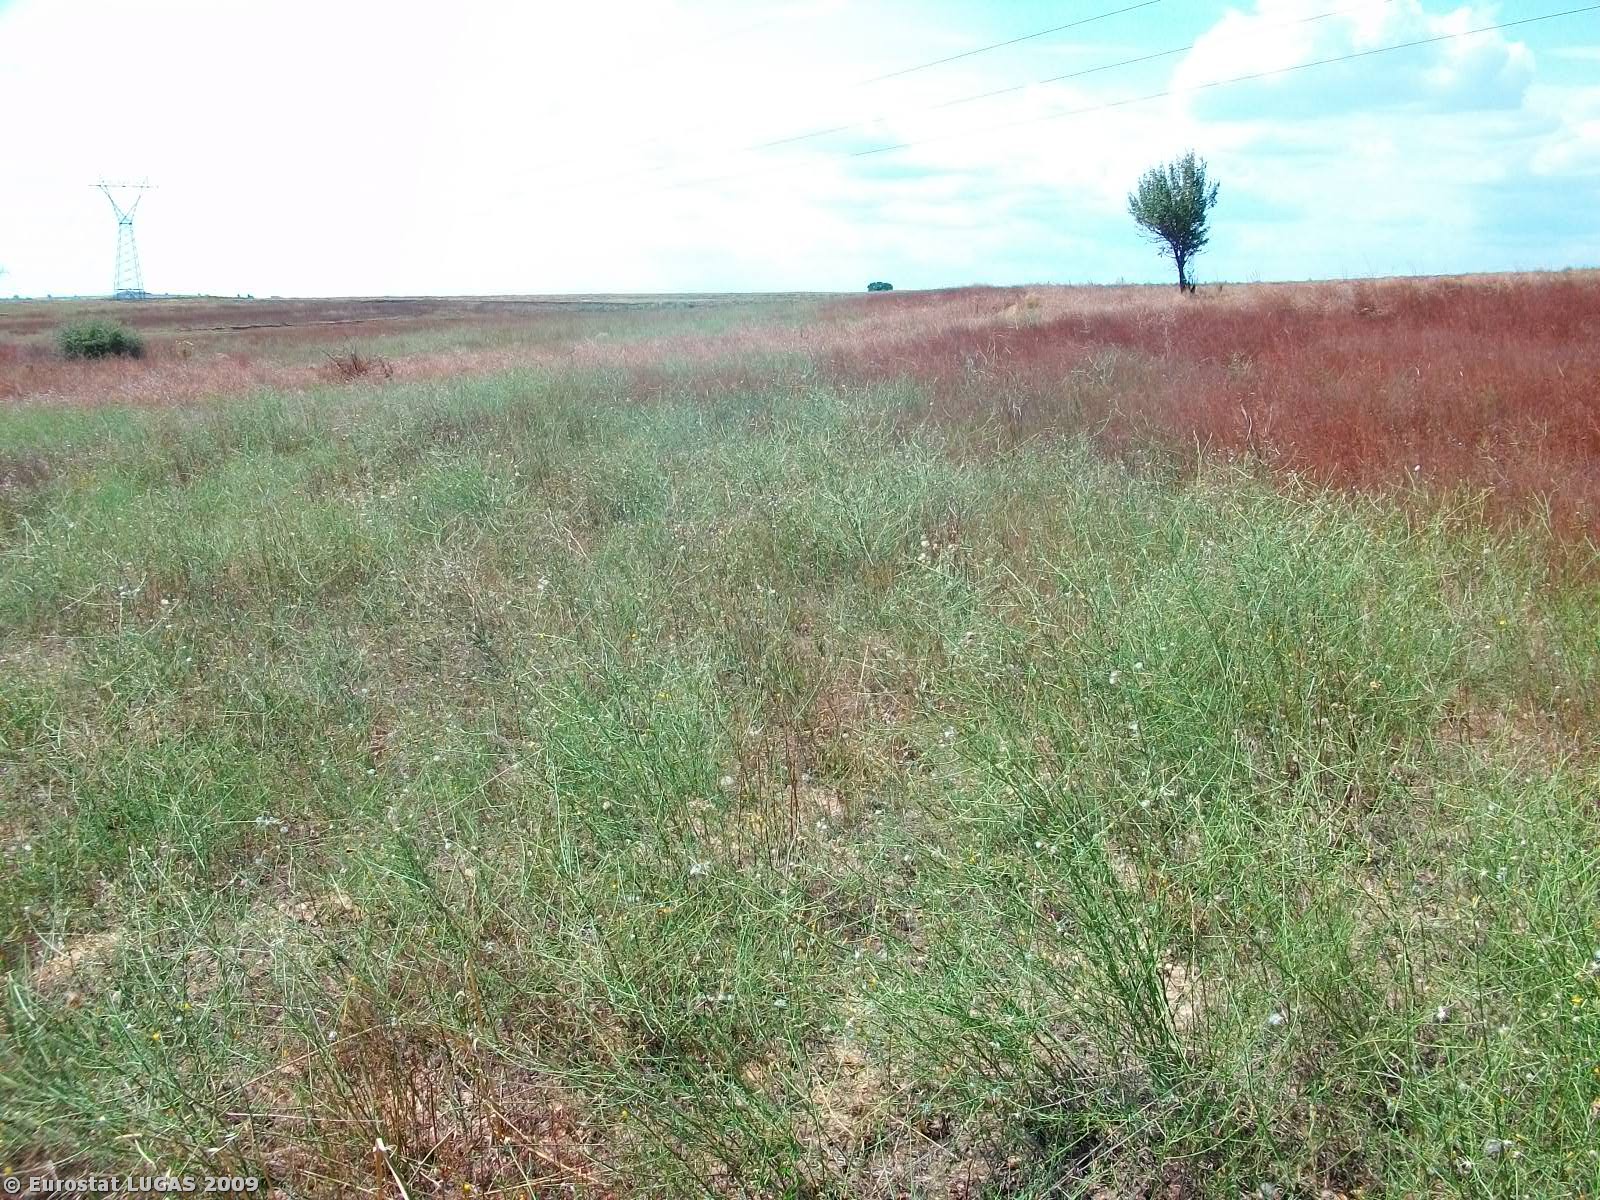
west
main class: Grassland
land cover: Grassland without tree/shrub cover
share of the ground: 50 - 75 %
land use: Unused
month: August
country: GR
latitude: 41.5078
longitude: 26.4067
